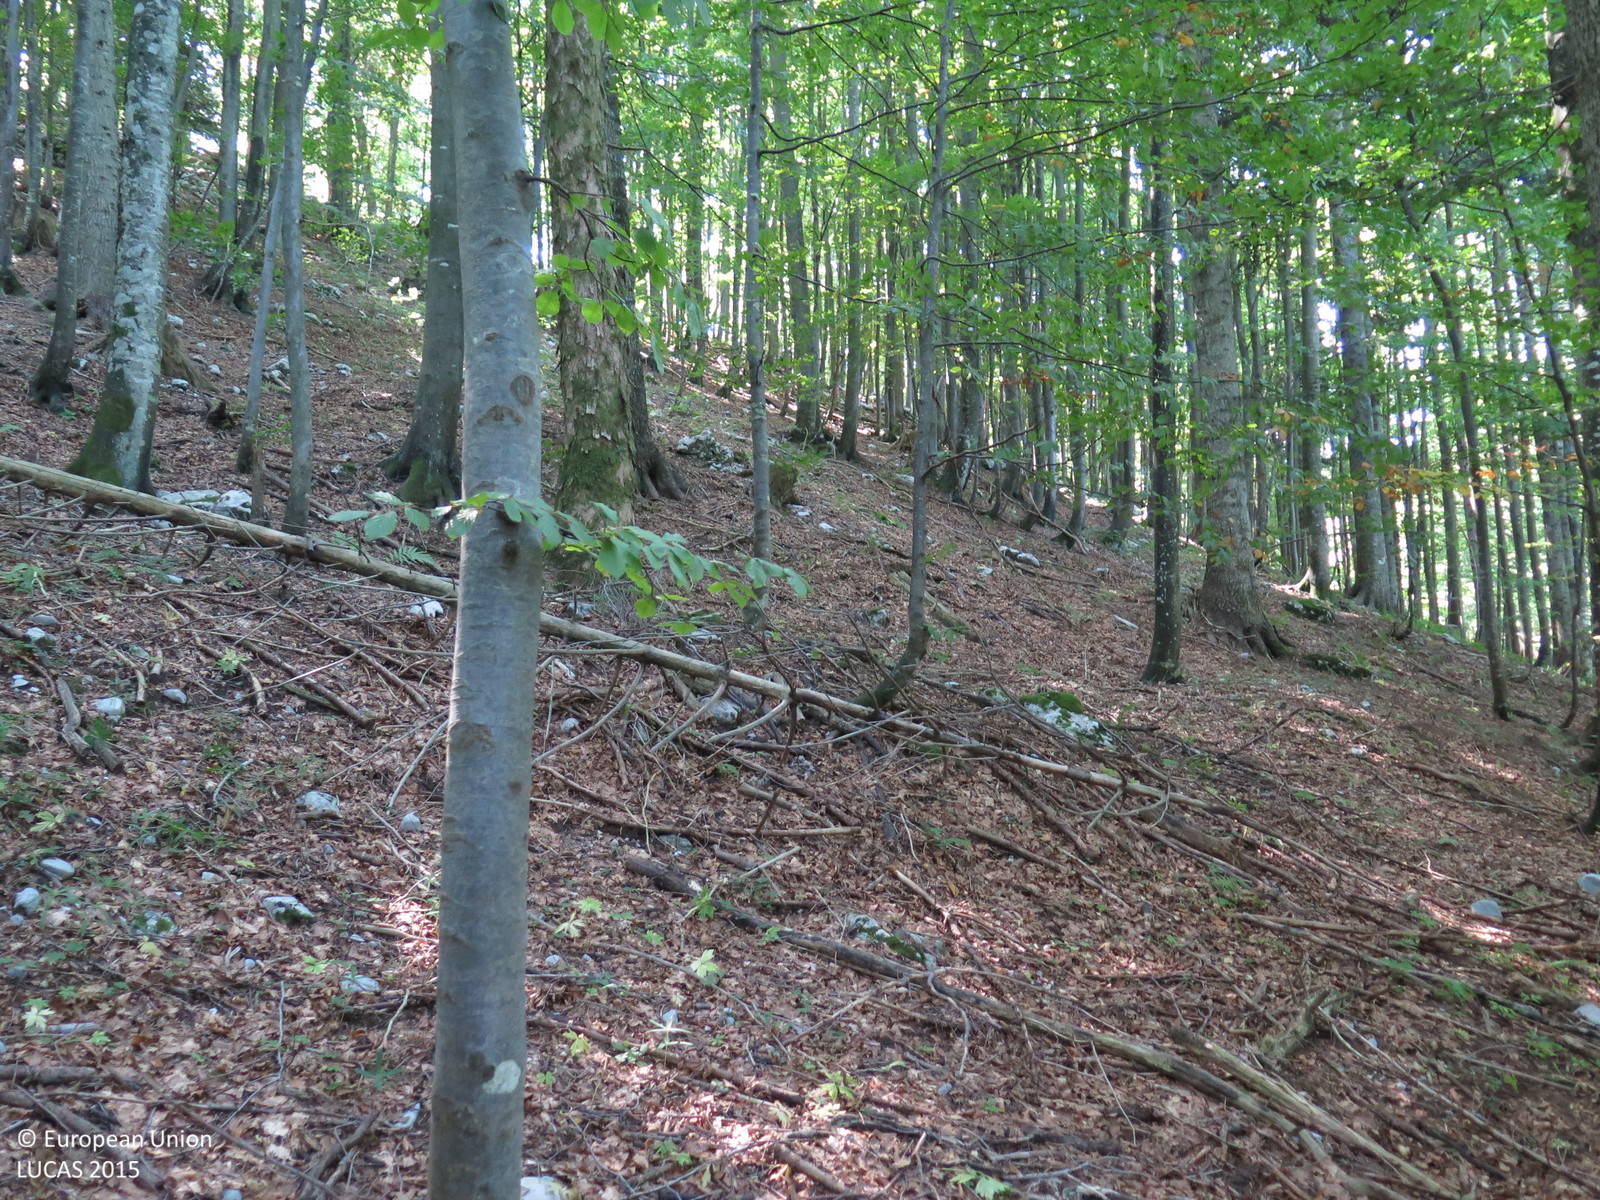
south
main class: Woodland
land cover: Other mixed woodland
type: mountainous beech forest
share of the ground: > 75 %
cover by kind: broadleaved forest trees 75 %, coniferous forest trees 25 %
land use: Forestry
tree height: > 5 m
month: September
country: HR
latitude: 45.5352
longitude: 14.4902
